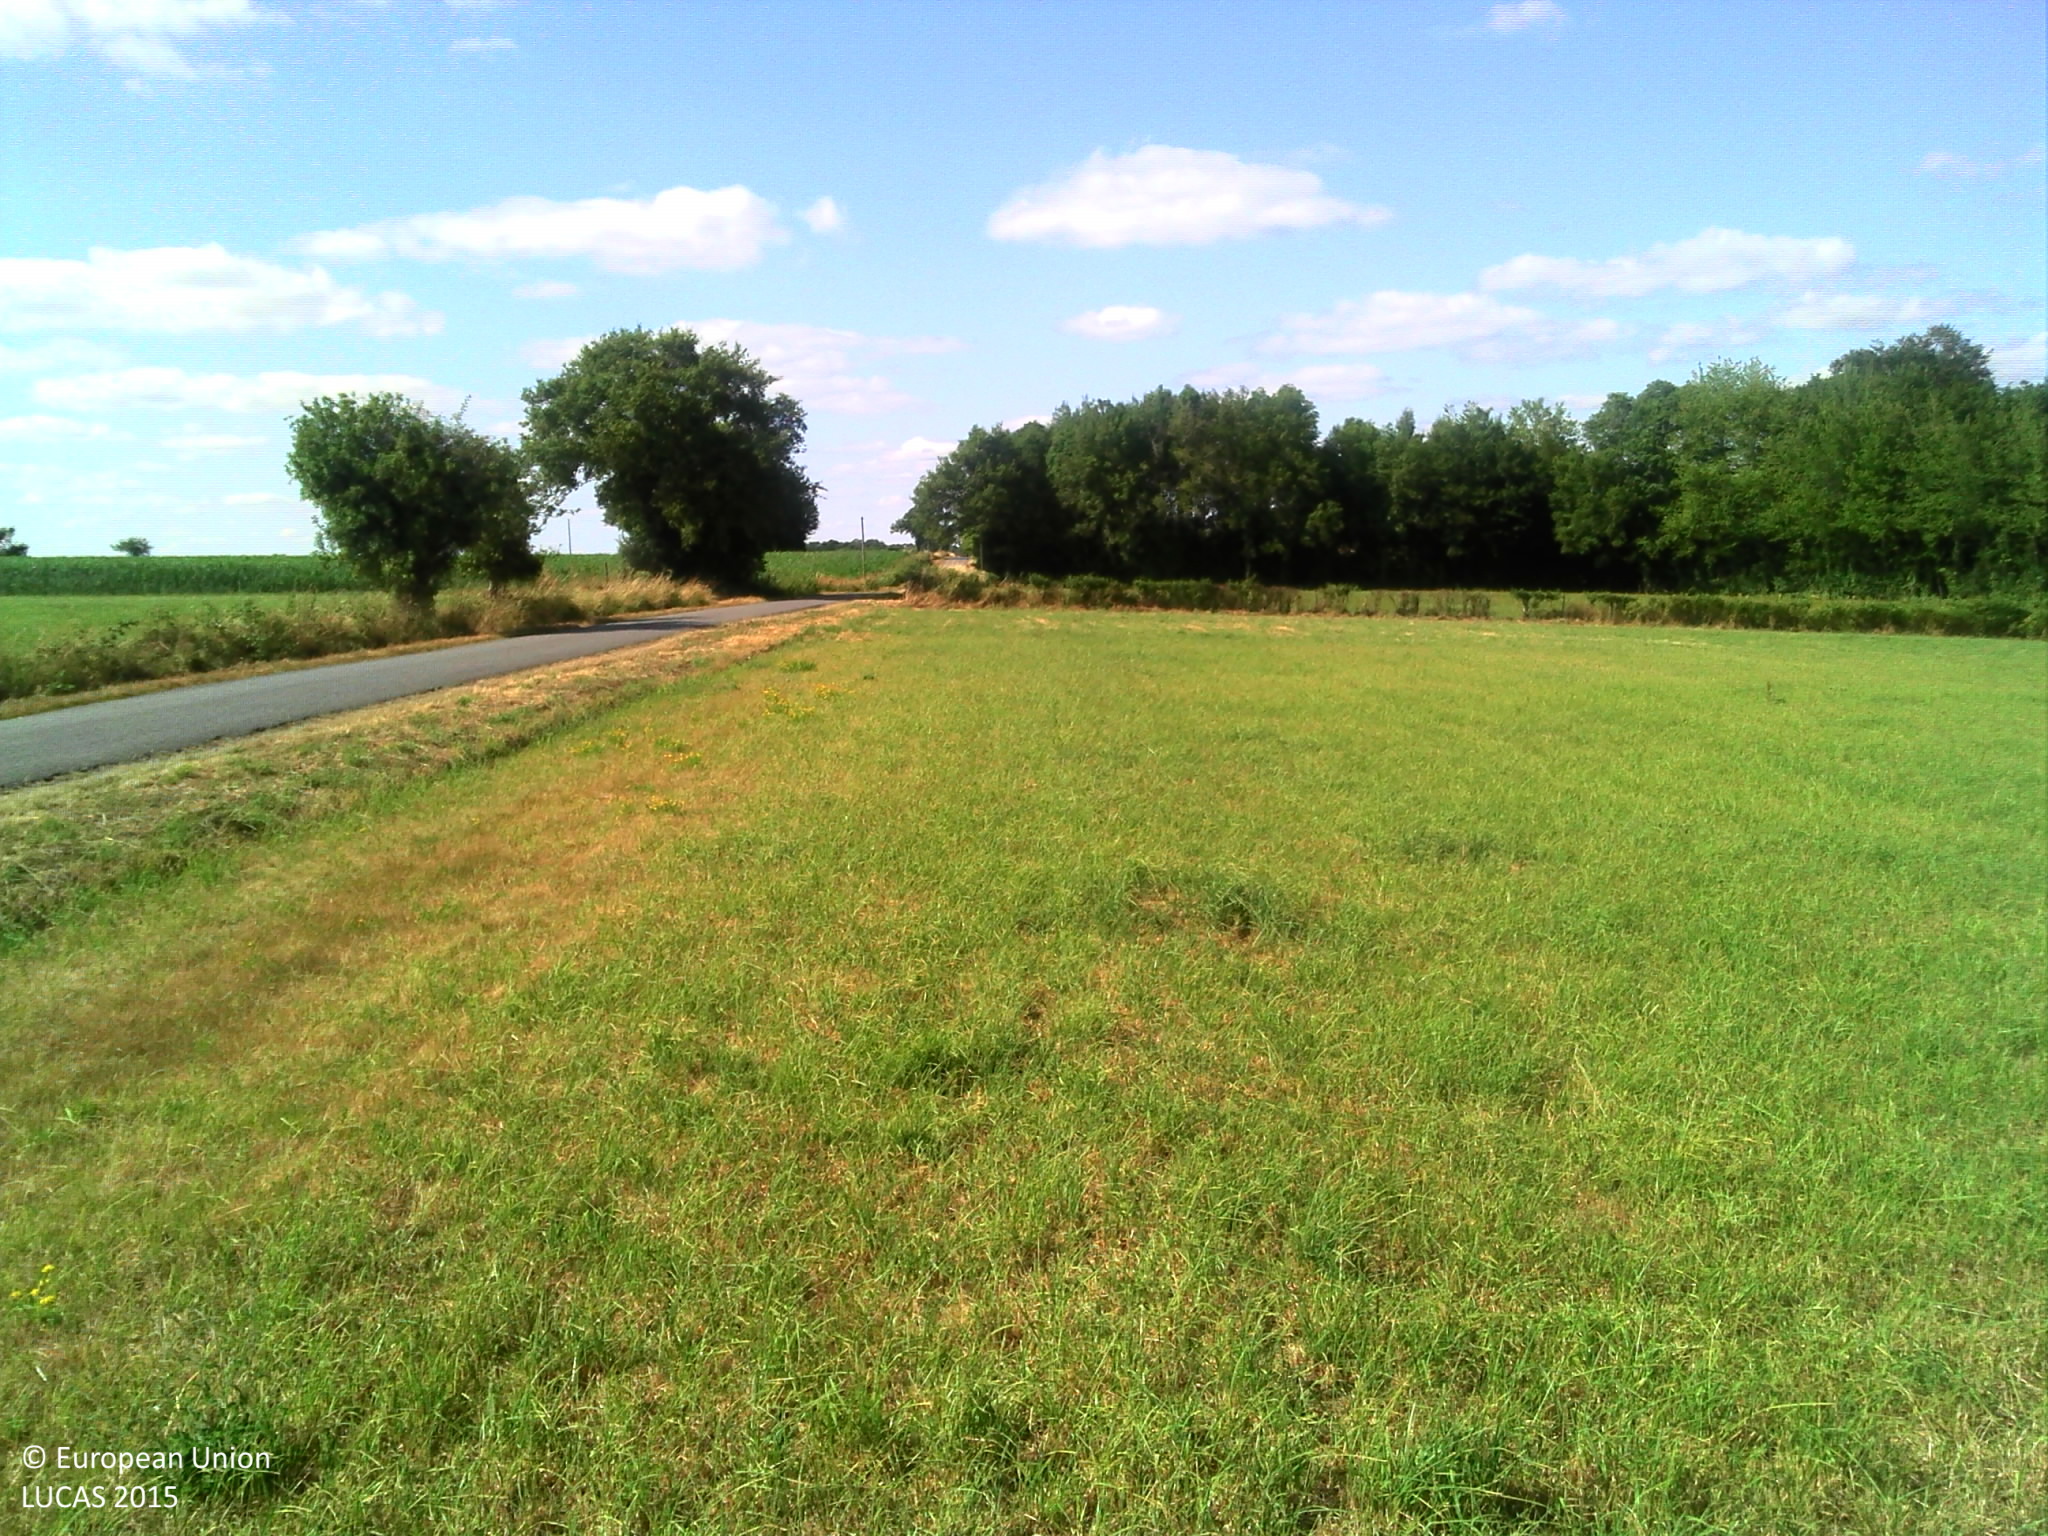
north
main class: Grassland
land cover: Grassland without tree/shrub cover
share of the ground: > 75 %
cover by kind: herbaceous plants 100 %
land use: Agriculture (excluding fallow land and kitchen gardens)
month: July
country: FR
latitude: 46.3113
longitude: 1.6155
